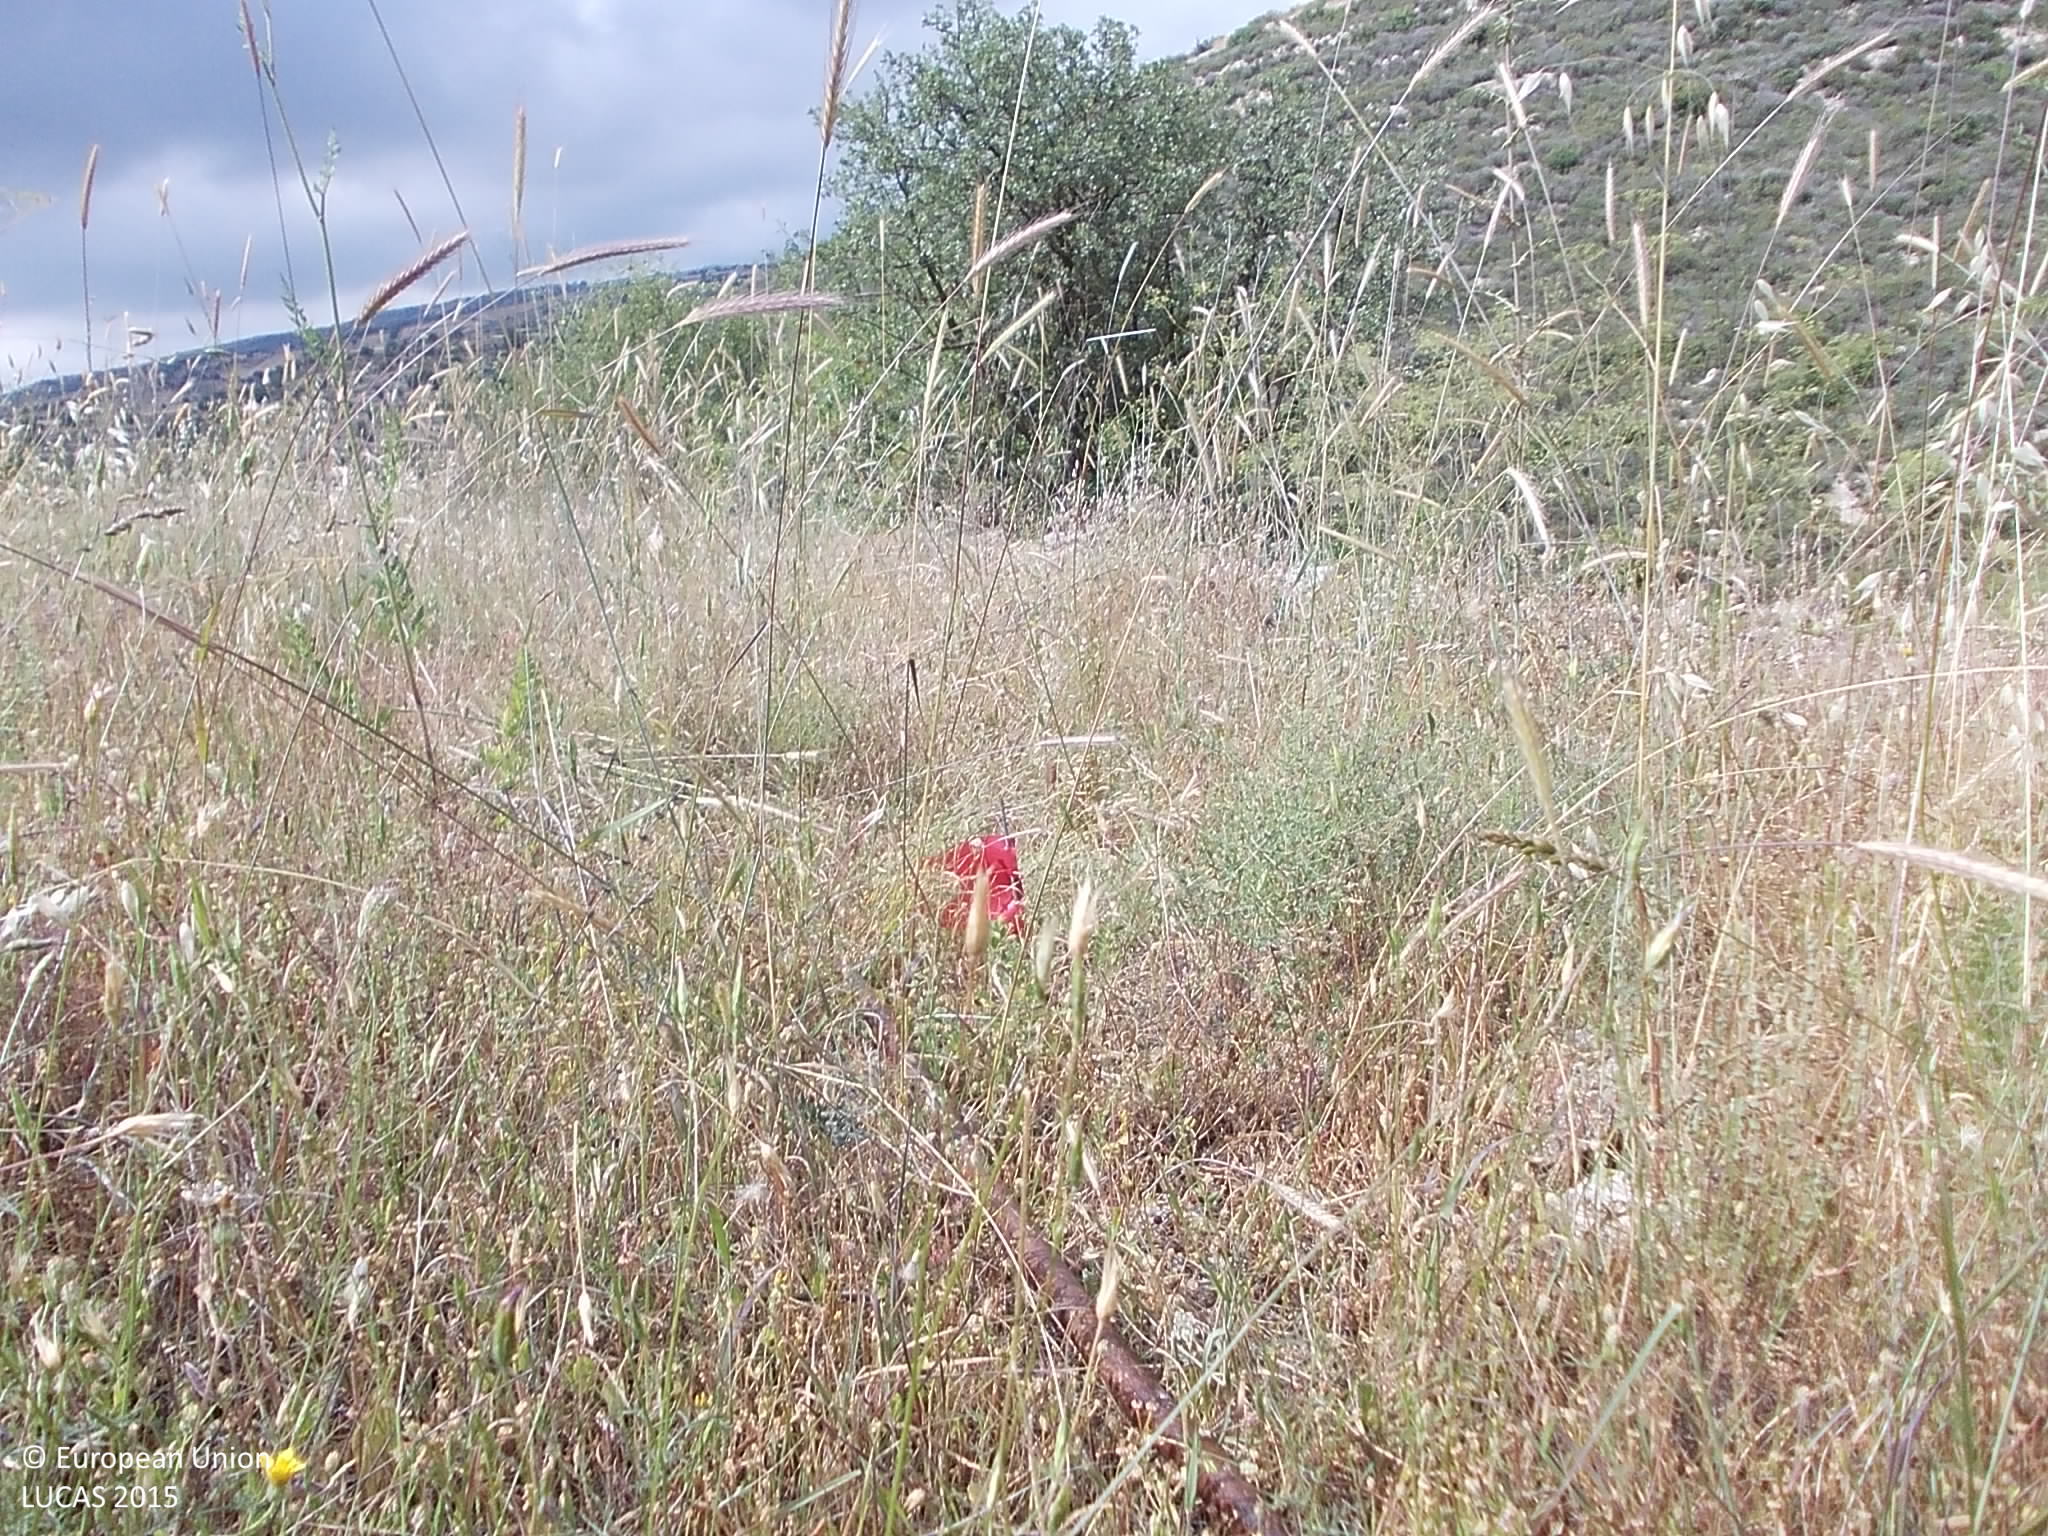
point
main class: Grassland
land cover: Grassland with sparse tree/shrub cover
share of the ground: > 75 %
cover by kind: herbaceous plants 85 %, broadleaved forest trees 5 %, shrubs 5 %, unconsolidated bare surface 5 %
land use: Abandoned areas
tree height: < 5 m
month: May
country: CY
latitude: 34.8078
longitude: 32.7983
